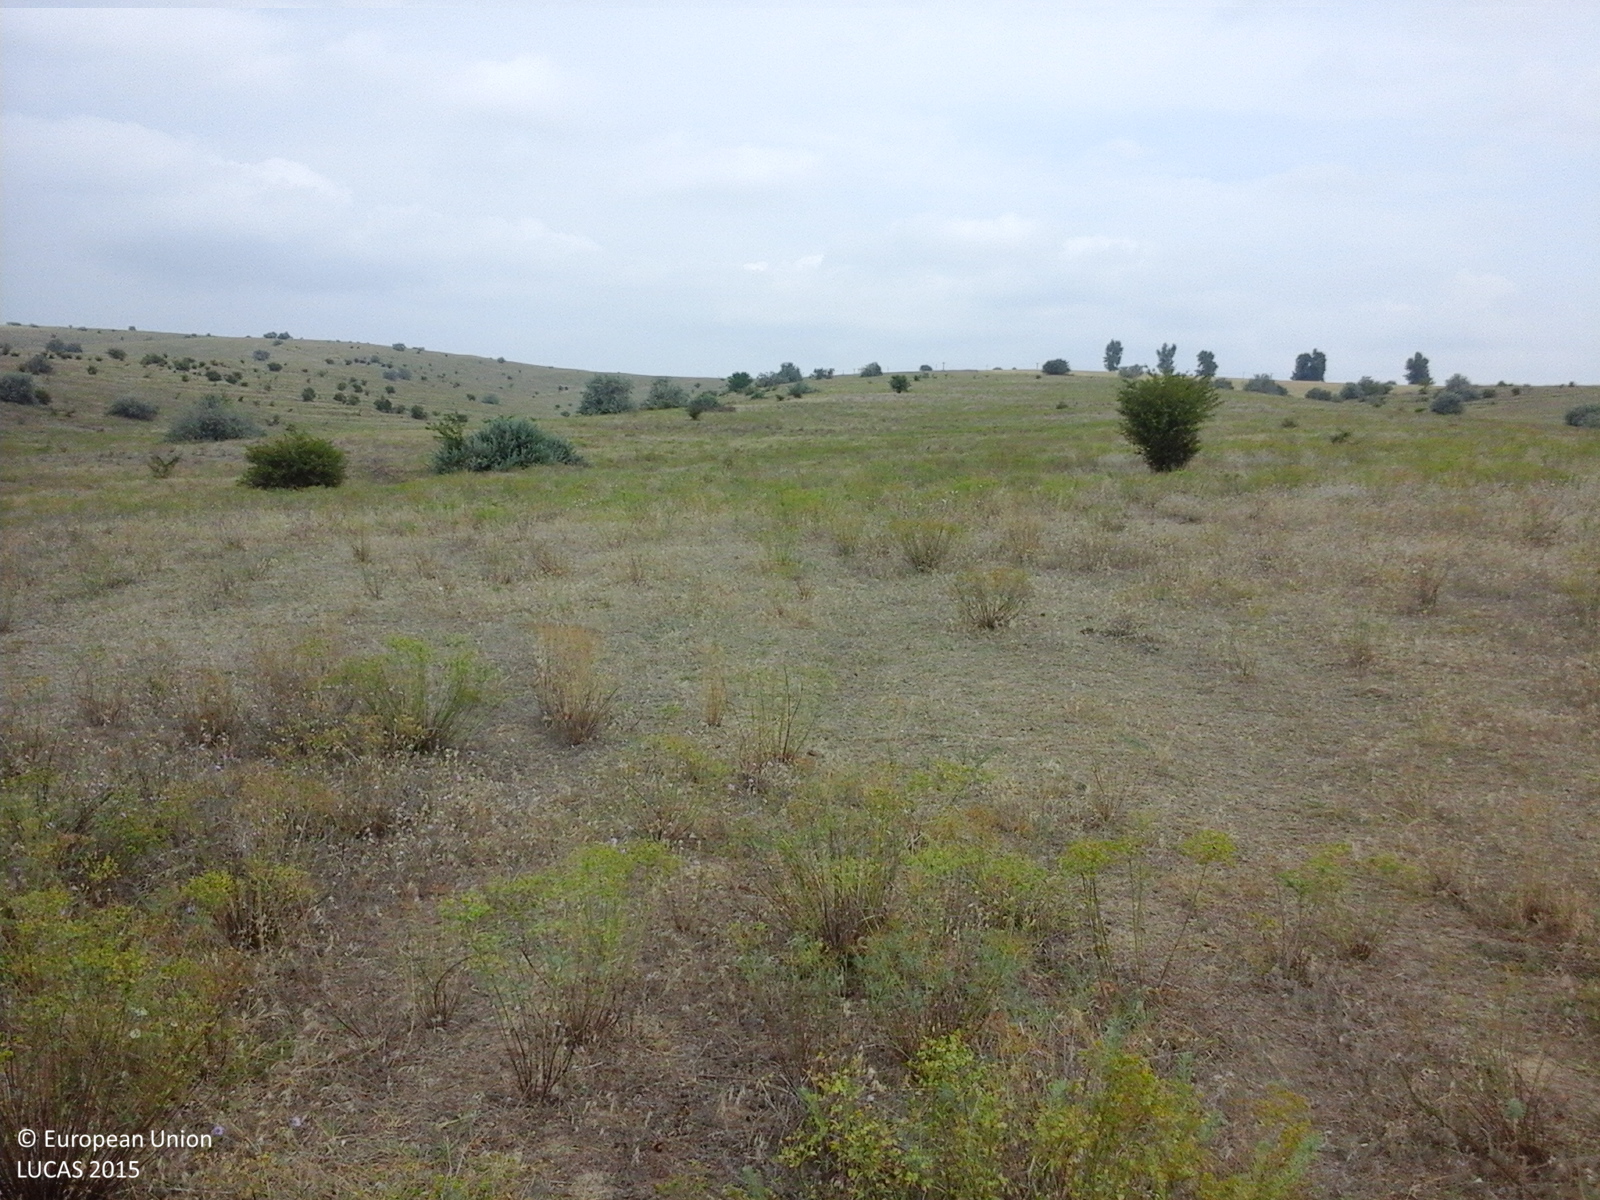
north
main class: Grassland
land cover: Grassland without tree/shrub cover
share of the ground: > 75 %
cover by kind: herbaceous plants 100 %
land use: Agriculture (excluding fallow land and kitchen gardens)
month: July
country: RO
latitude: 44.9818
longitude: 28.1641
